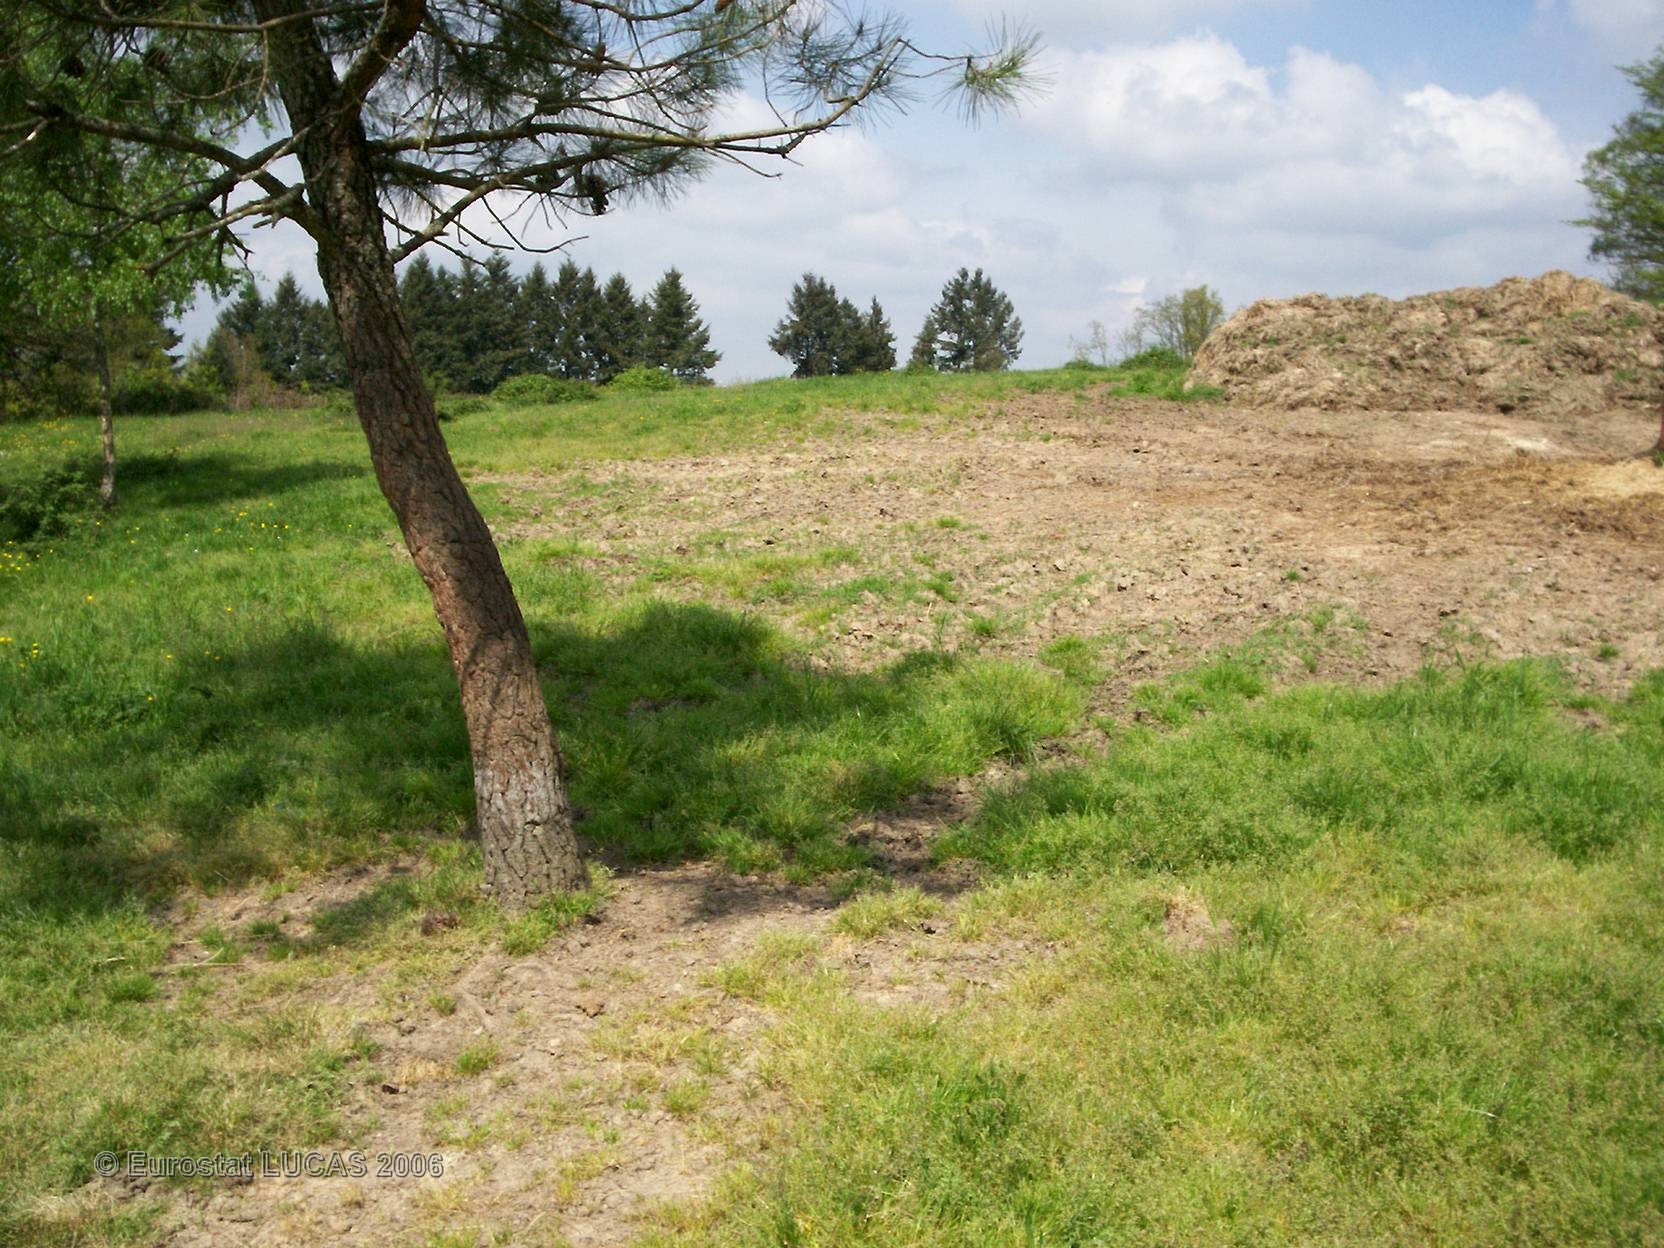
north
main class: Grassland
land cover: Grassland with sparse tree/shrub cover
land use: Agriculture (excluding fallow land and kitchen gardens)
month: April
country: FR
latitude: 45.5533
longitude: 0.7786
